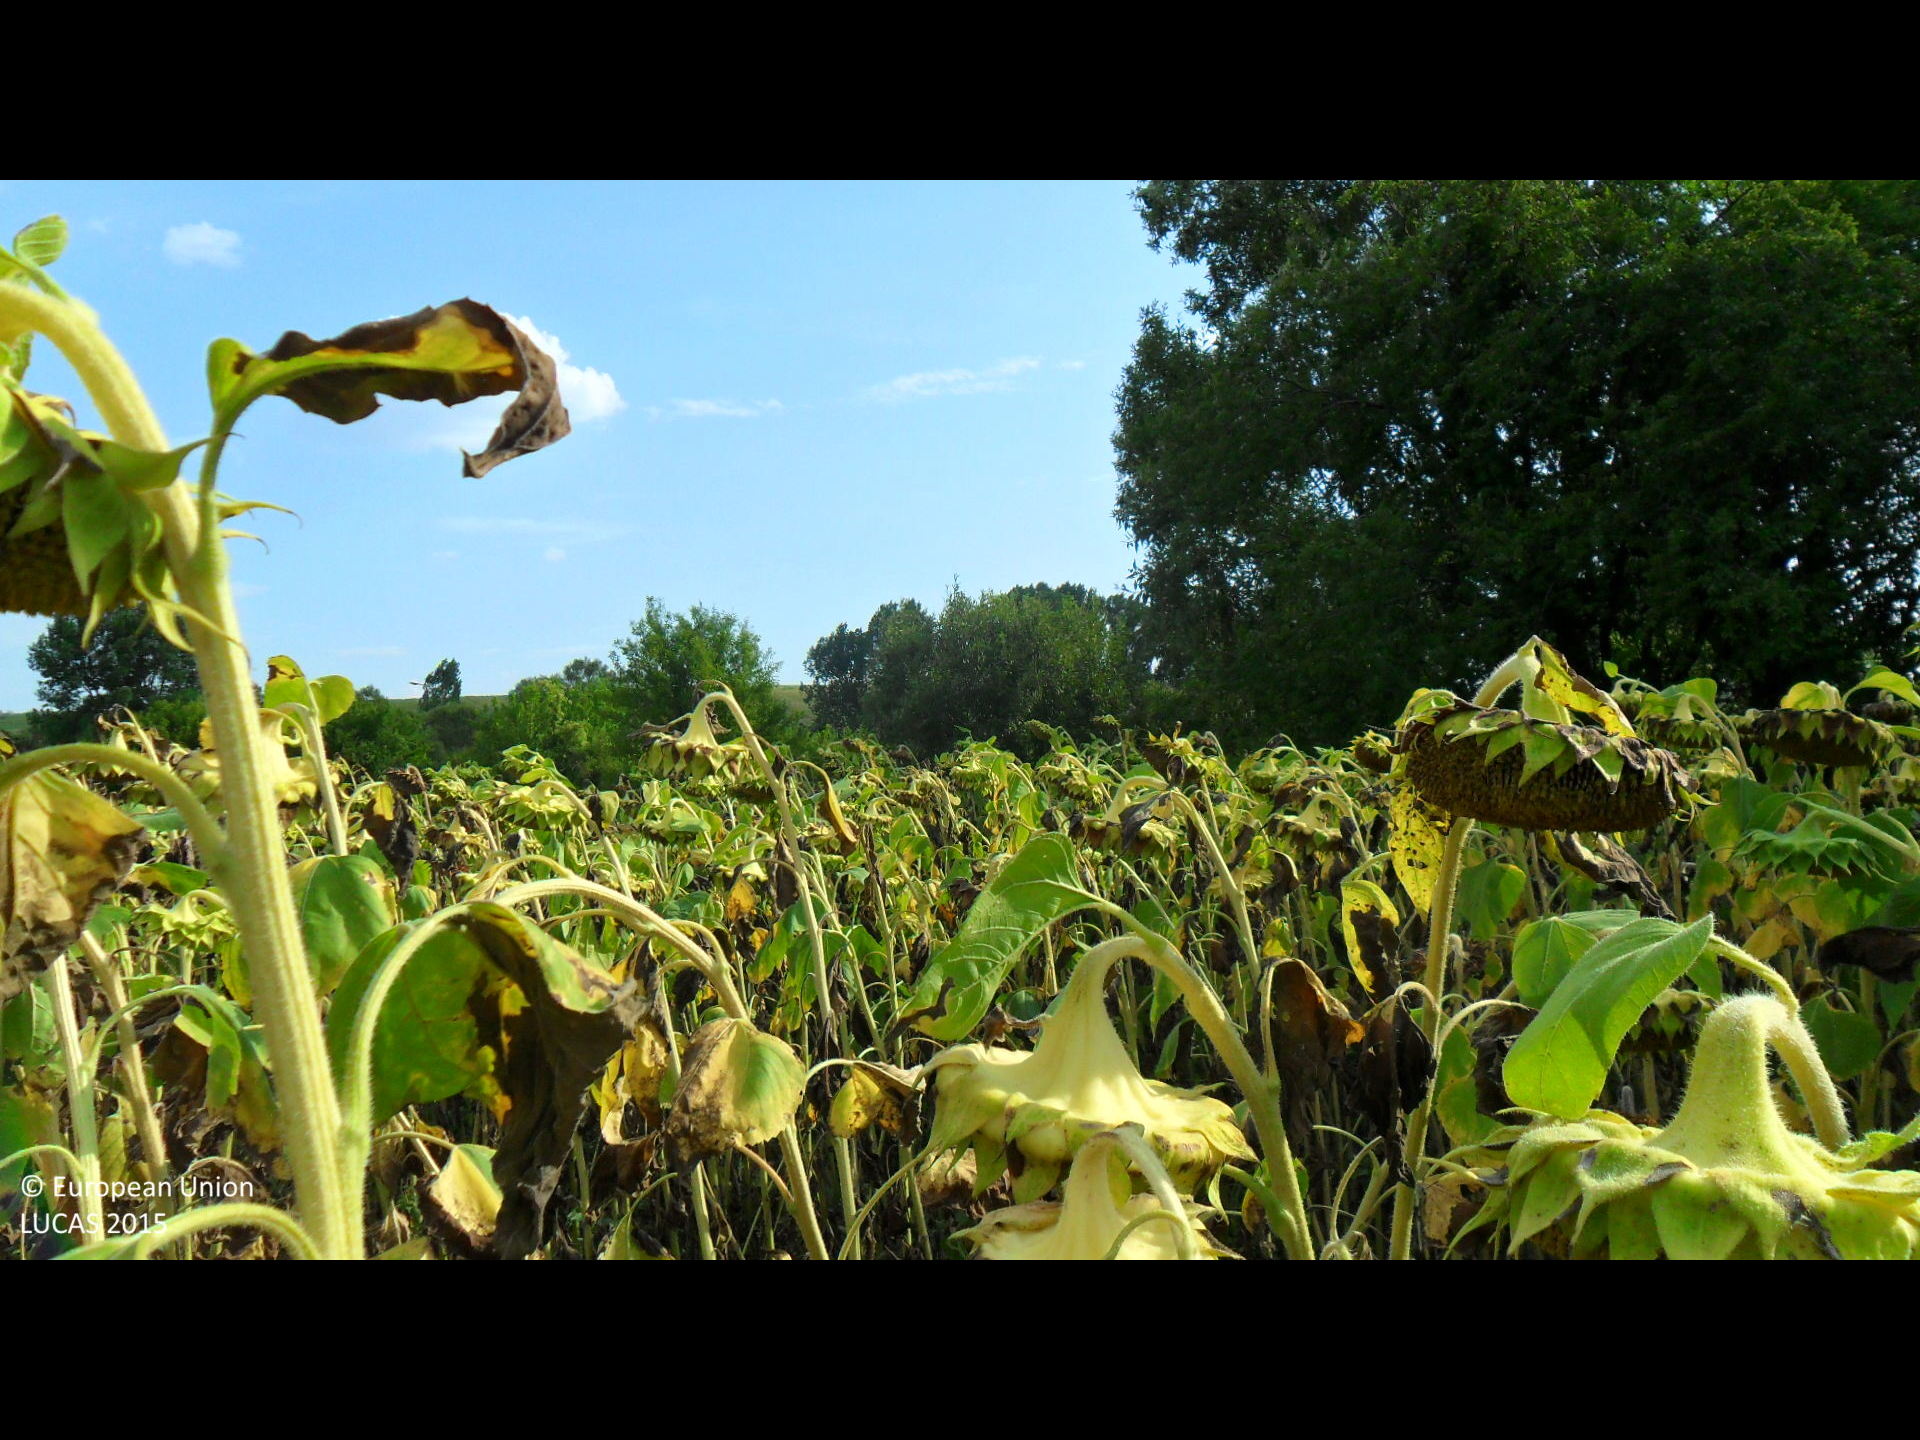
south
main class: Cropland
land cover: Sunflower
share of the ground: > 75 %
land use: Agriculture (excluding fallow land and kitchen gardens)
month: August
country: BG
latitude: 43.3555
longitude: 26.1210
